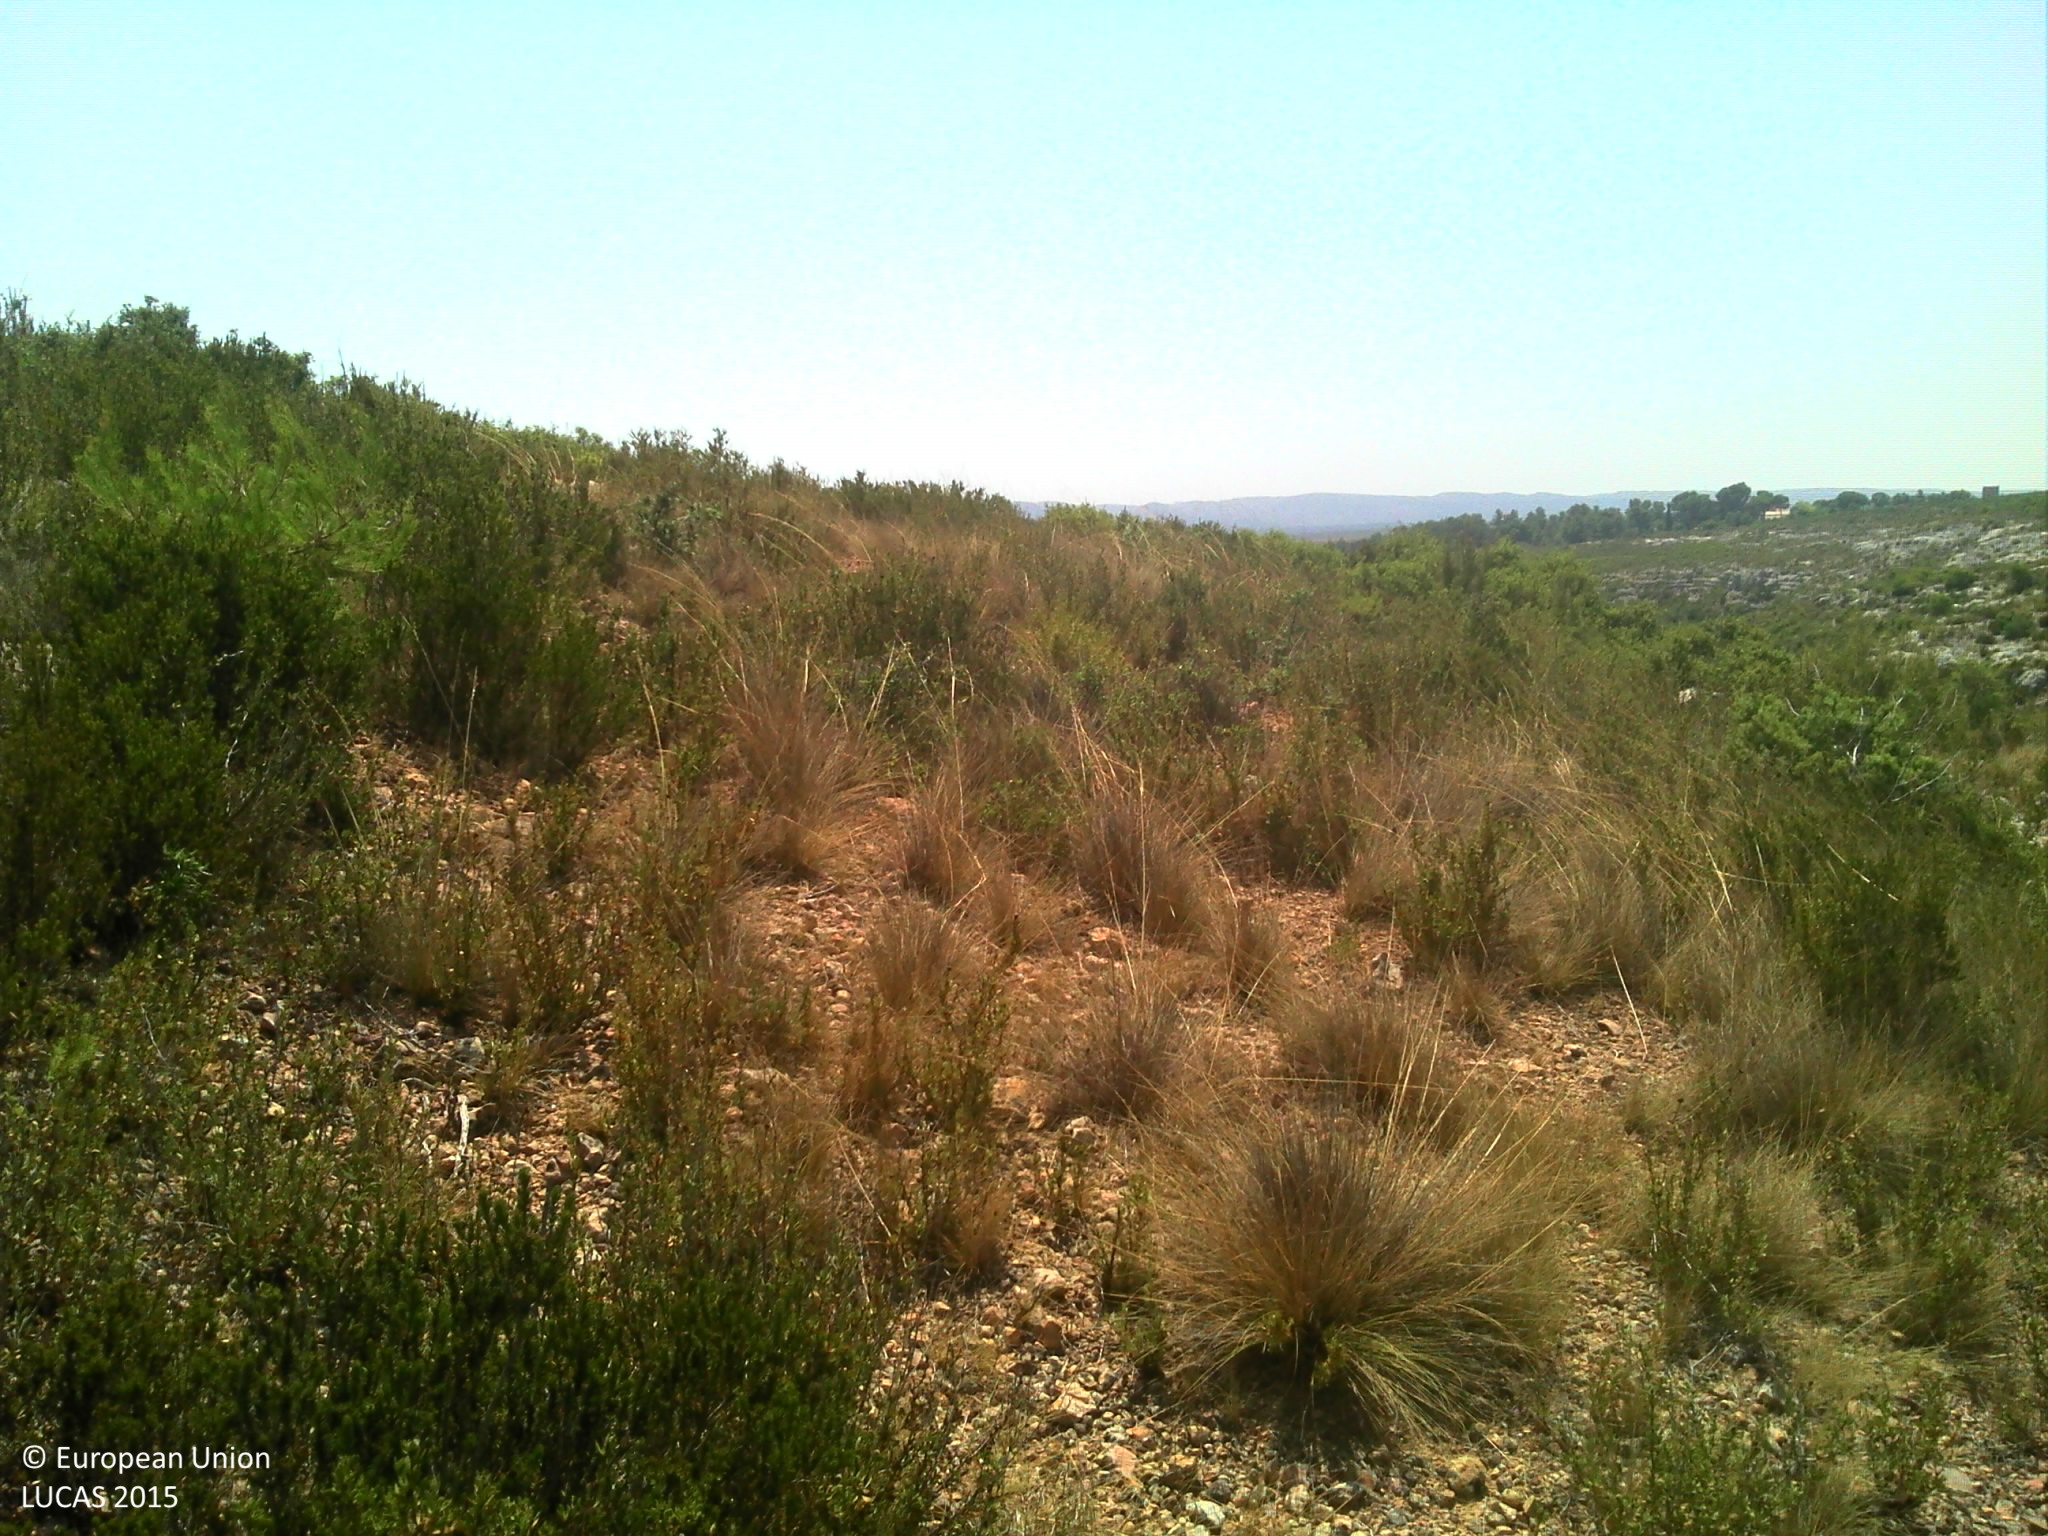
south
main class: Shrubland
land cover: Shrubland without tree cover
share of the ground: > 75 %
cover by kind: shrubs 80 %, unconsolidated bare surface 15 %, consolidated bare surface 5 %
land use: Semi-natural and natural areas not in use
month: August
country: FR
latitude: 43.4660
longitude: 5.2759
